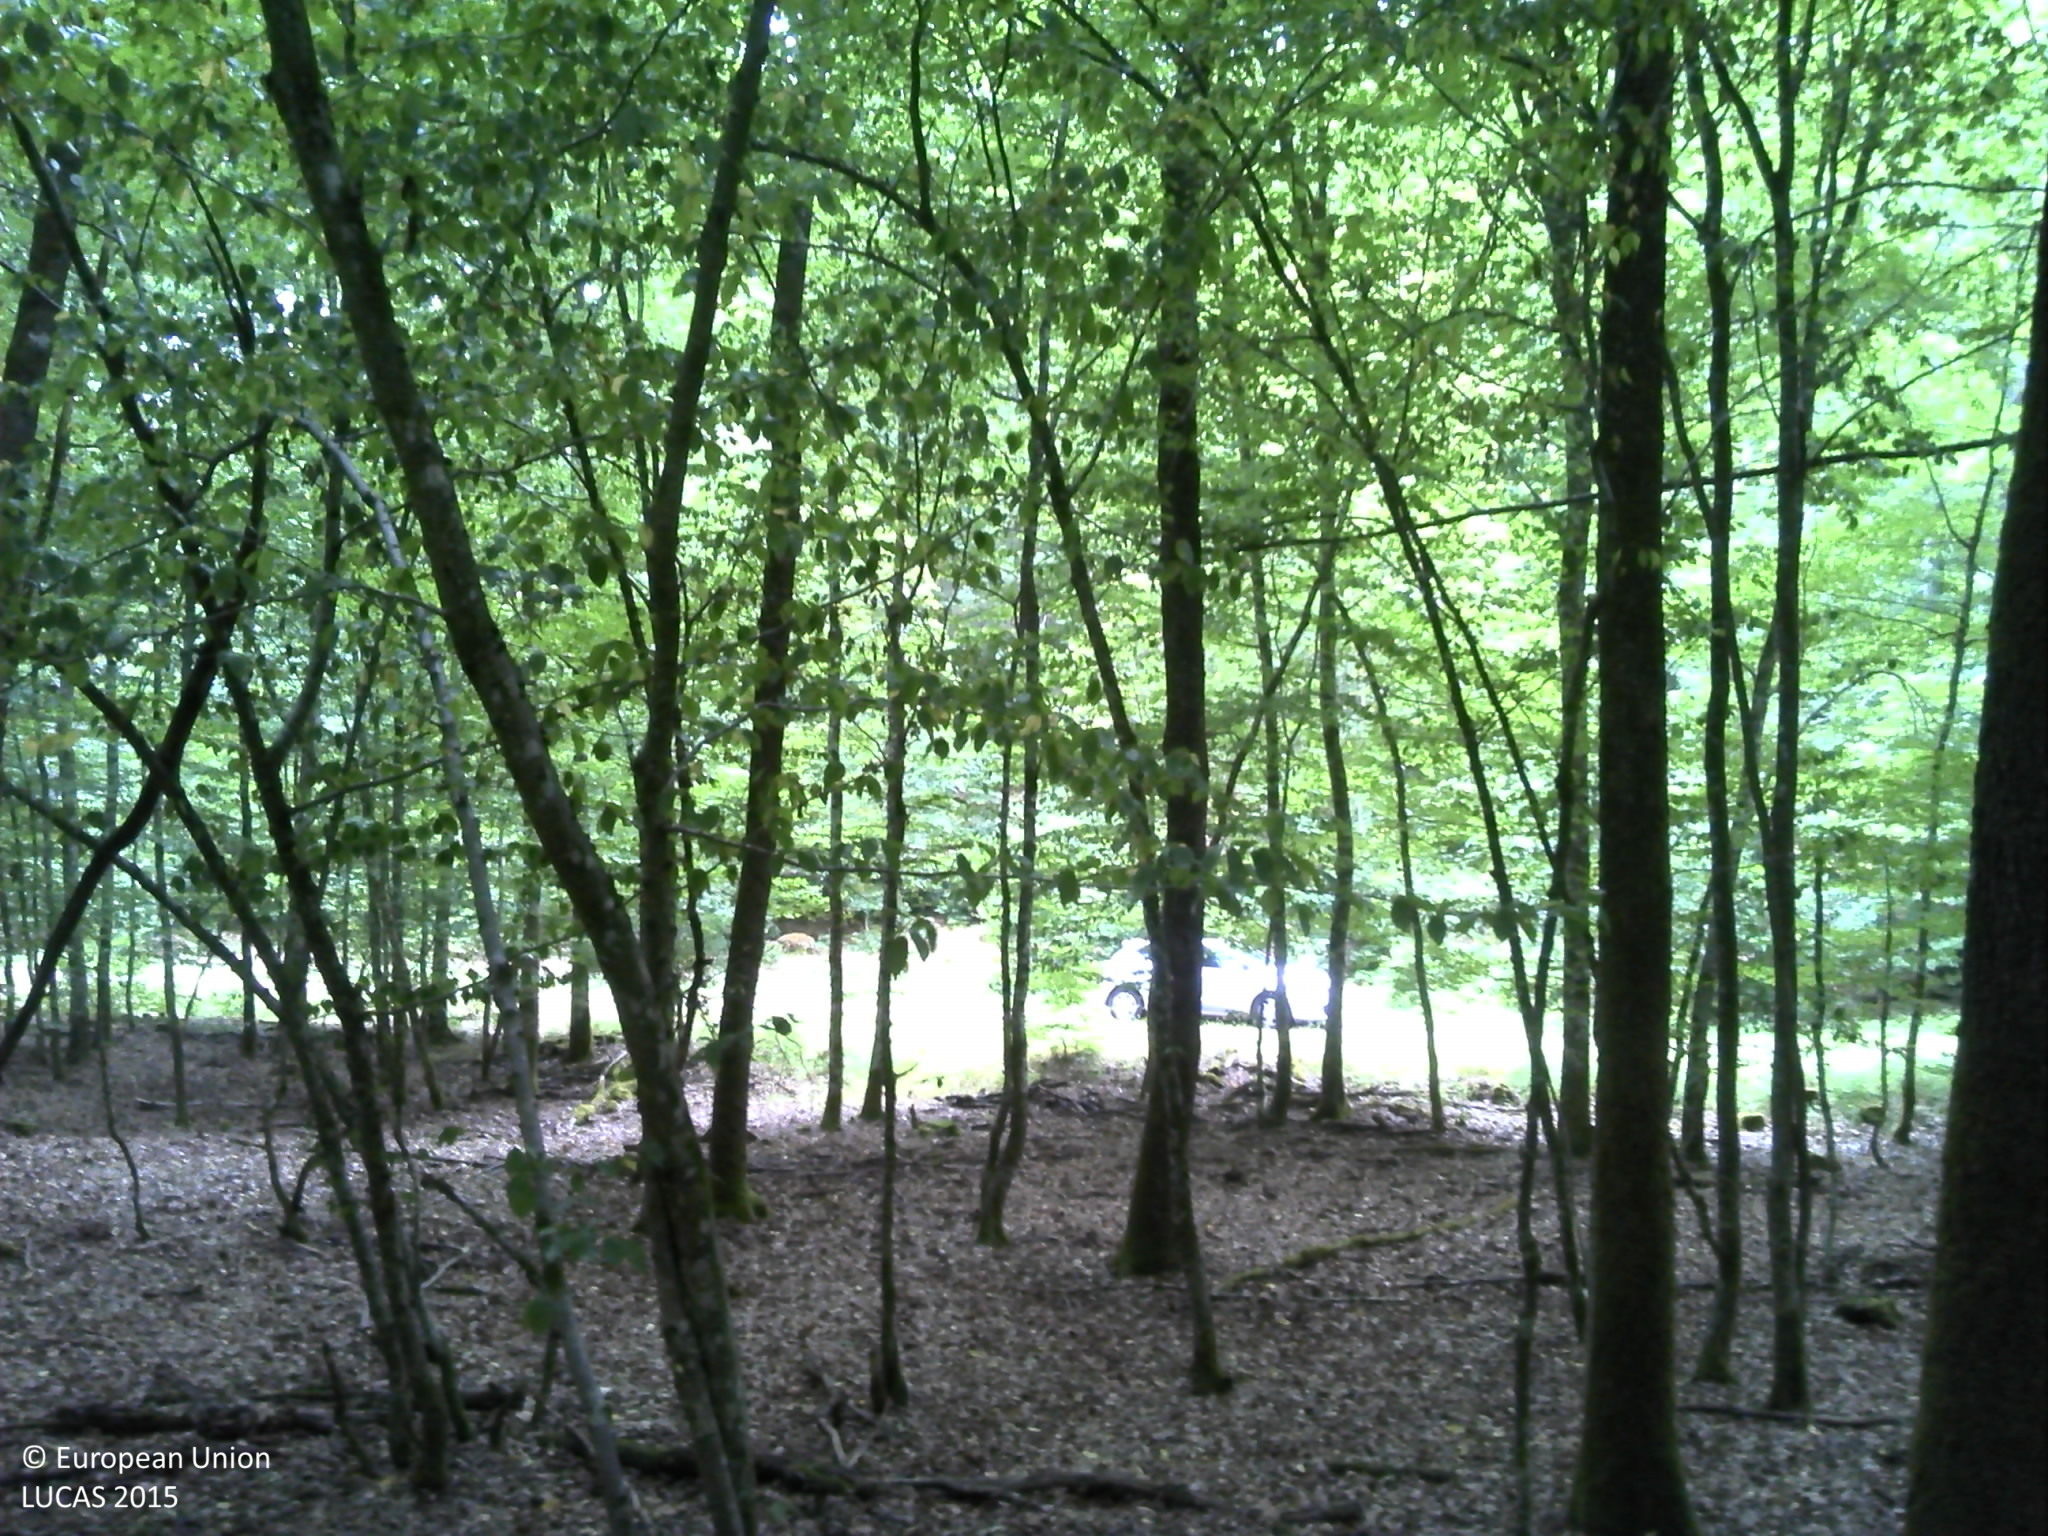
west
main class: Woodland
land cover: Broadleaved woodland
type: mesophytic deciduous forest
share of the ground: > 75 %
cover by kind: broadleaved forest trees 100 %
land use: Forestry
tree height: > 5 m
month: July
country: FR
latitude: 49.0418
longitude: 7.5244
